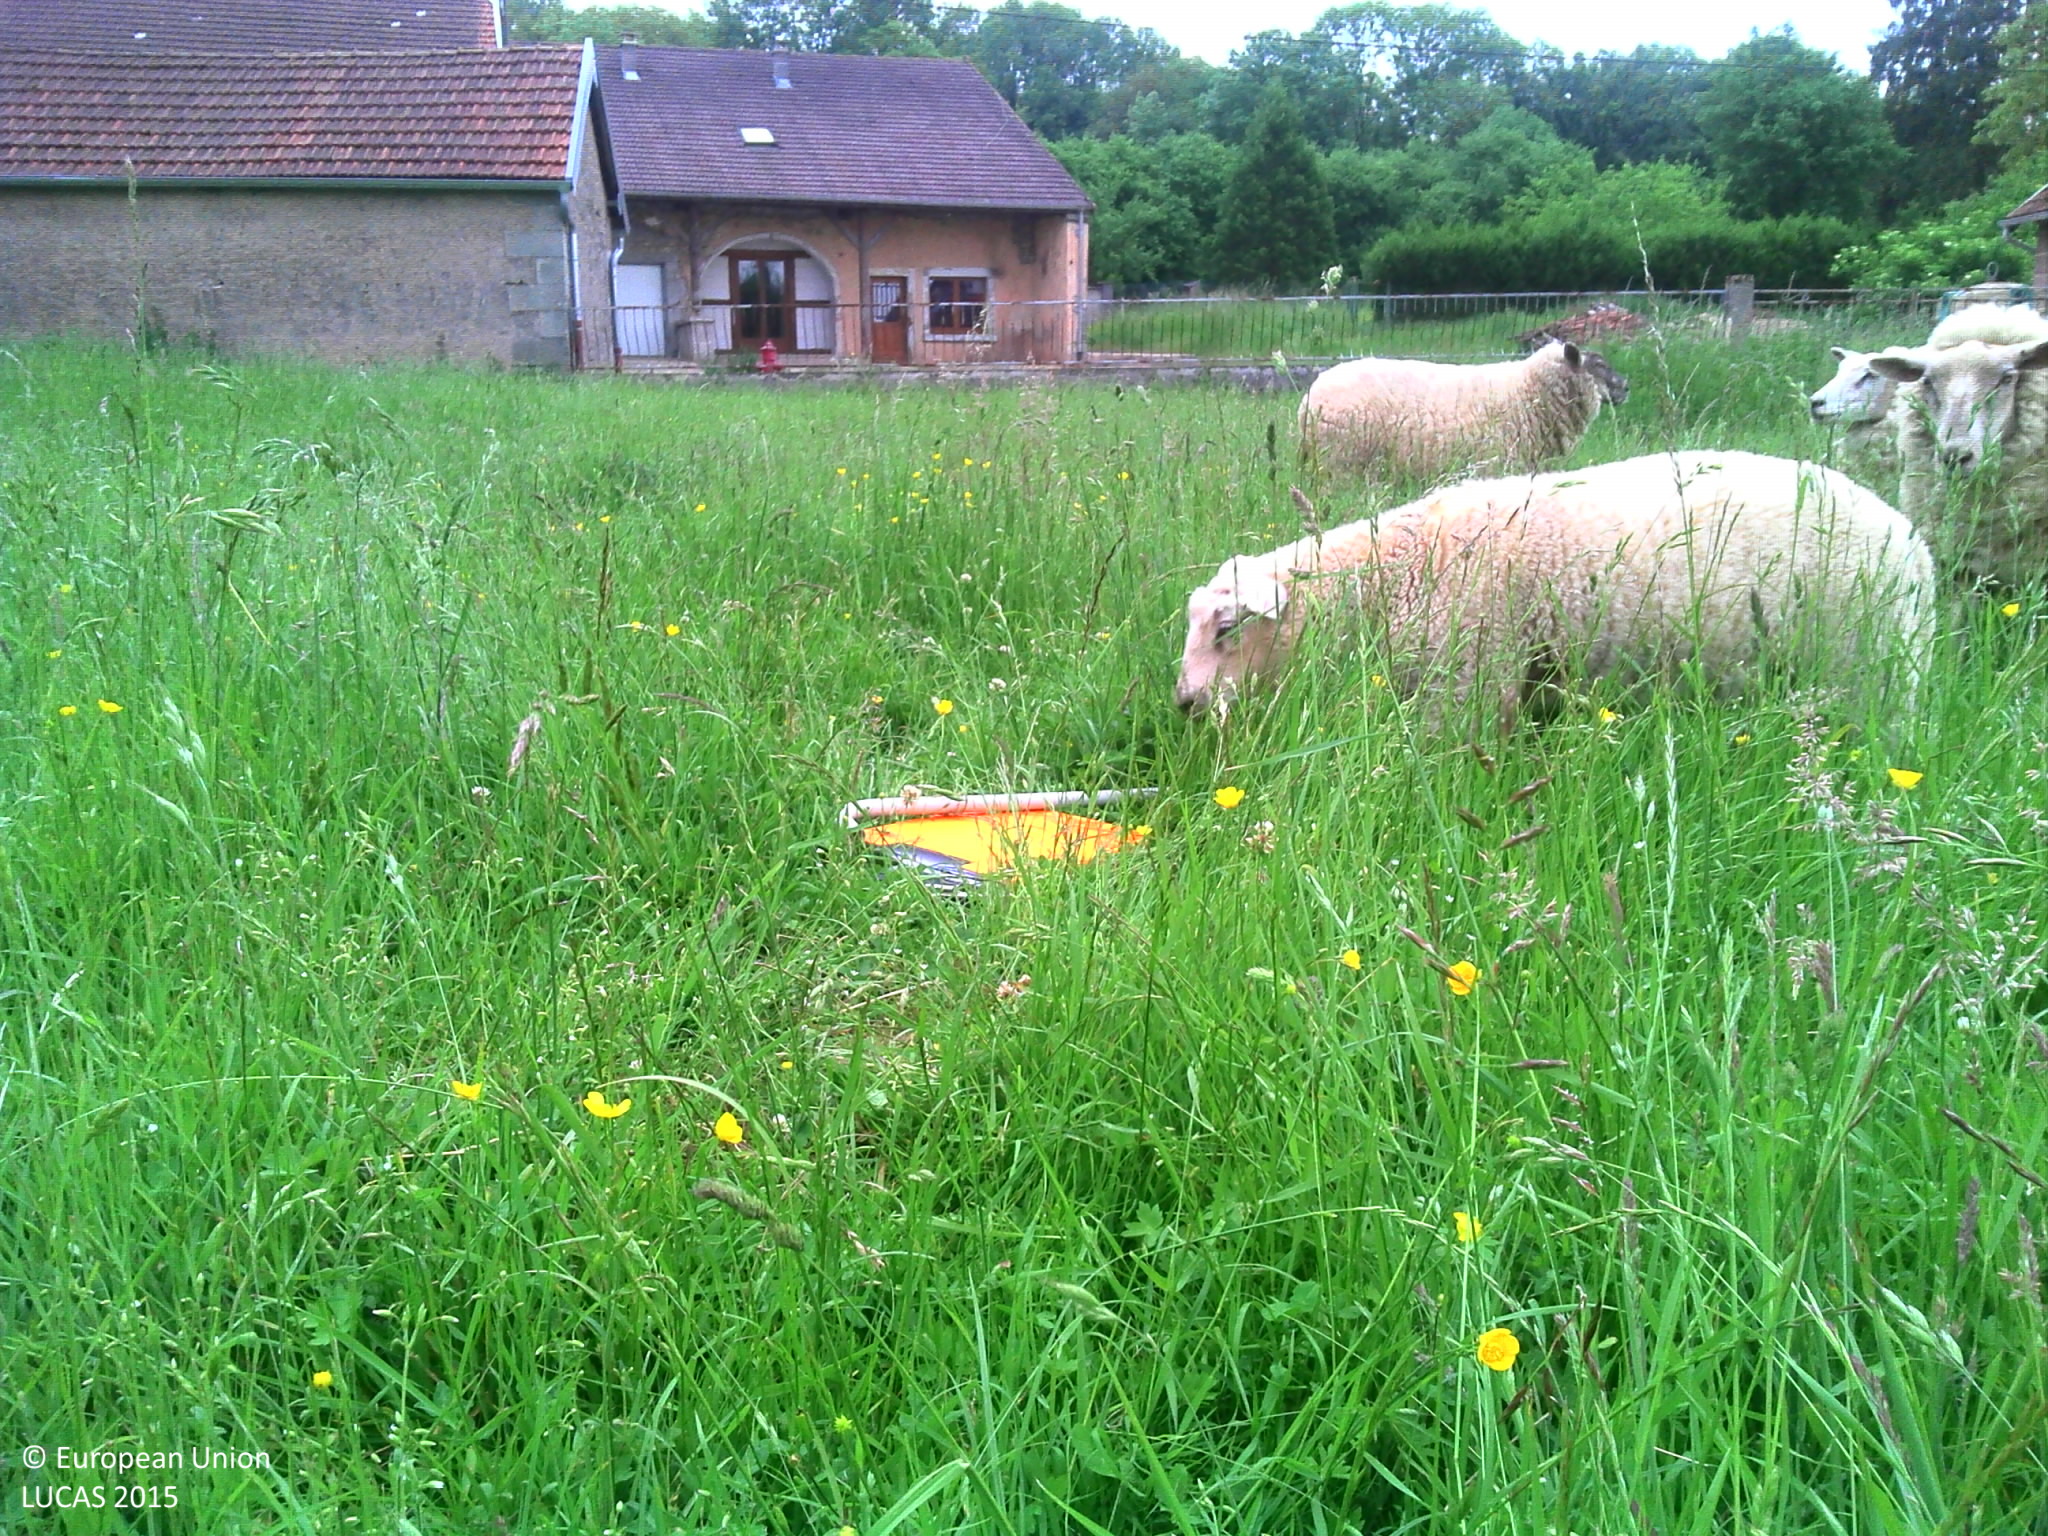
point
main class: Grassland
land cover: Grassland without tree/shrub cover
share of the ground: > 75 %
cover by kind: herbaceous plants 100 %
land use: Agriculture (excluding fallow land and kitchen gardens)
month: May
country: FR
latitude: 47.9216
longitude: 6.1333
